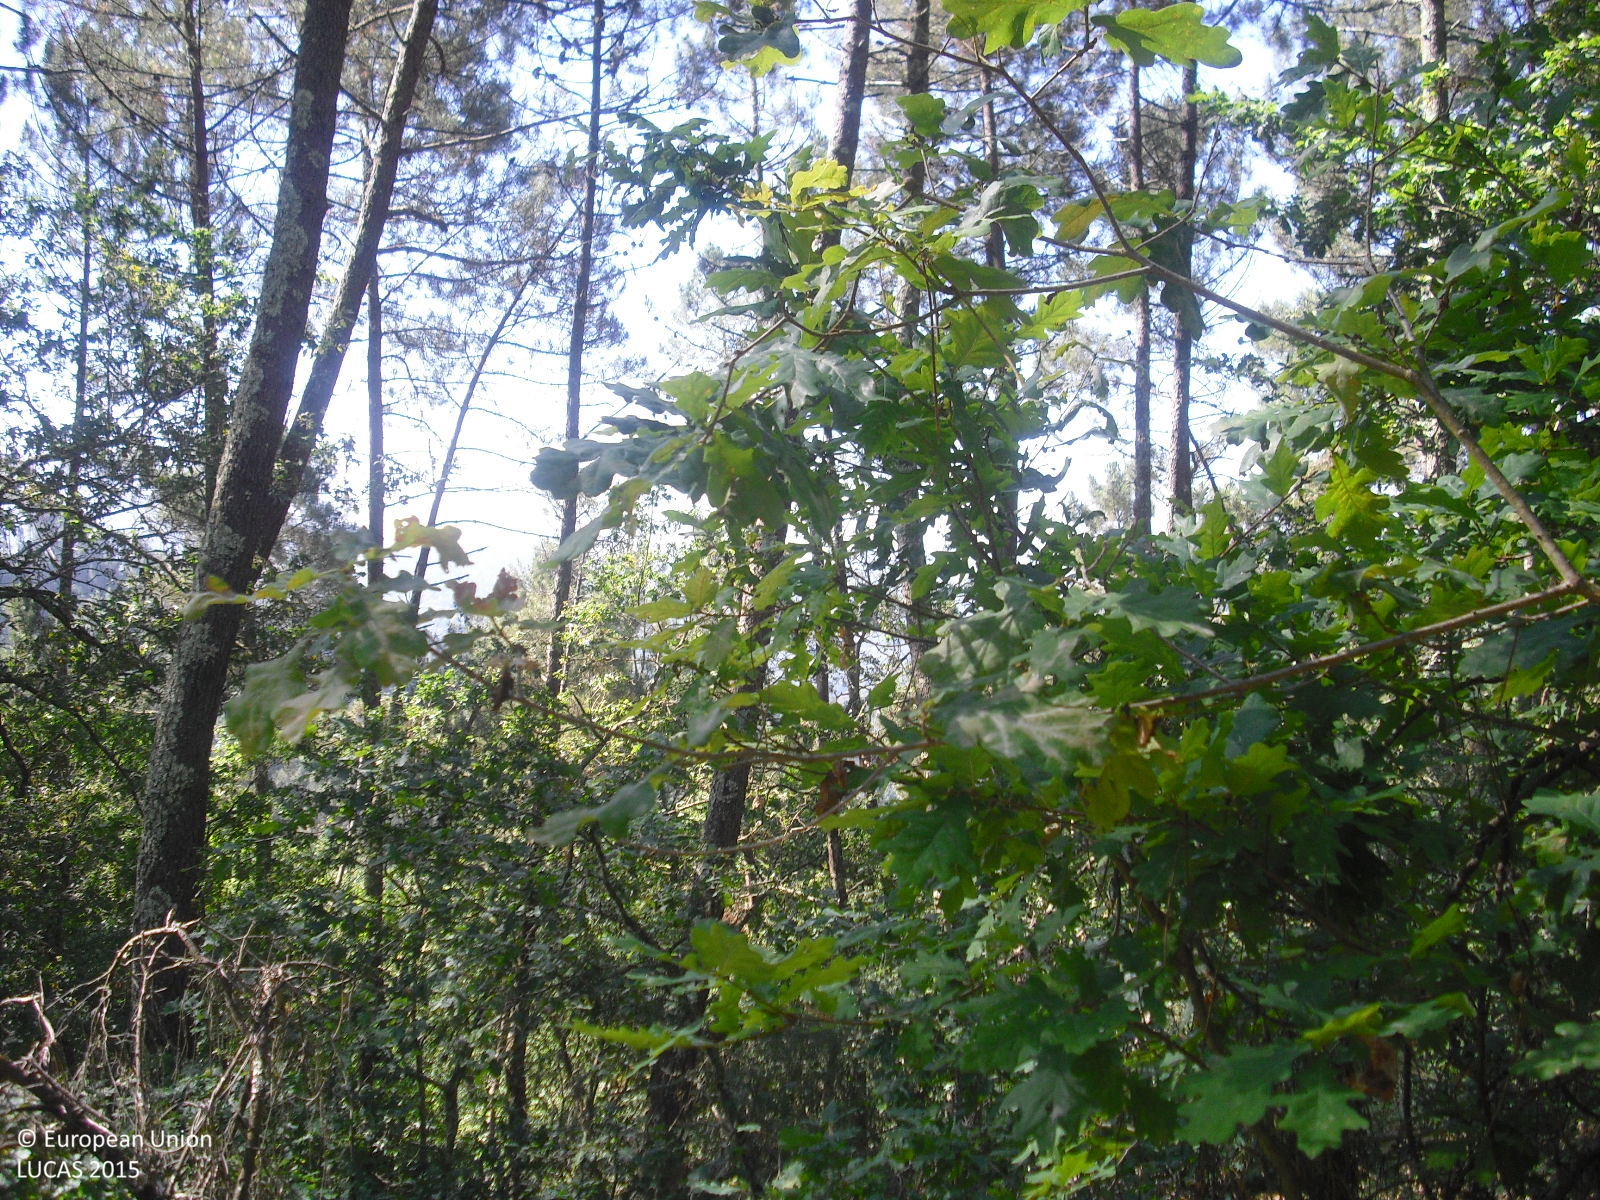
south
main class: Woodland
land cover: Pine dominated mixed woodland
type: hemiboreal forest and nemoral coniferous forest and mixed broadleaved-coniferous forest
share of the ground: > 75 %
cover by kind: coniferous forest trees 50 %, shrubs 30 %, broadleaved forest trees 20 %
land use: Forestry
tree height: > 5 m
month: June
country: ES
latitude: 42.4299
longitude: -7.7859
